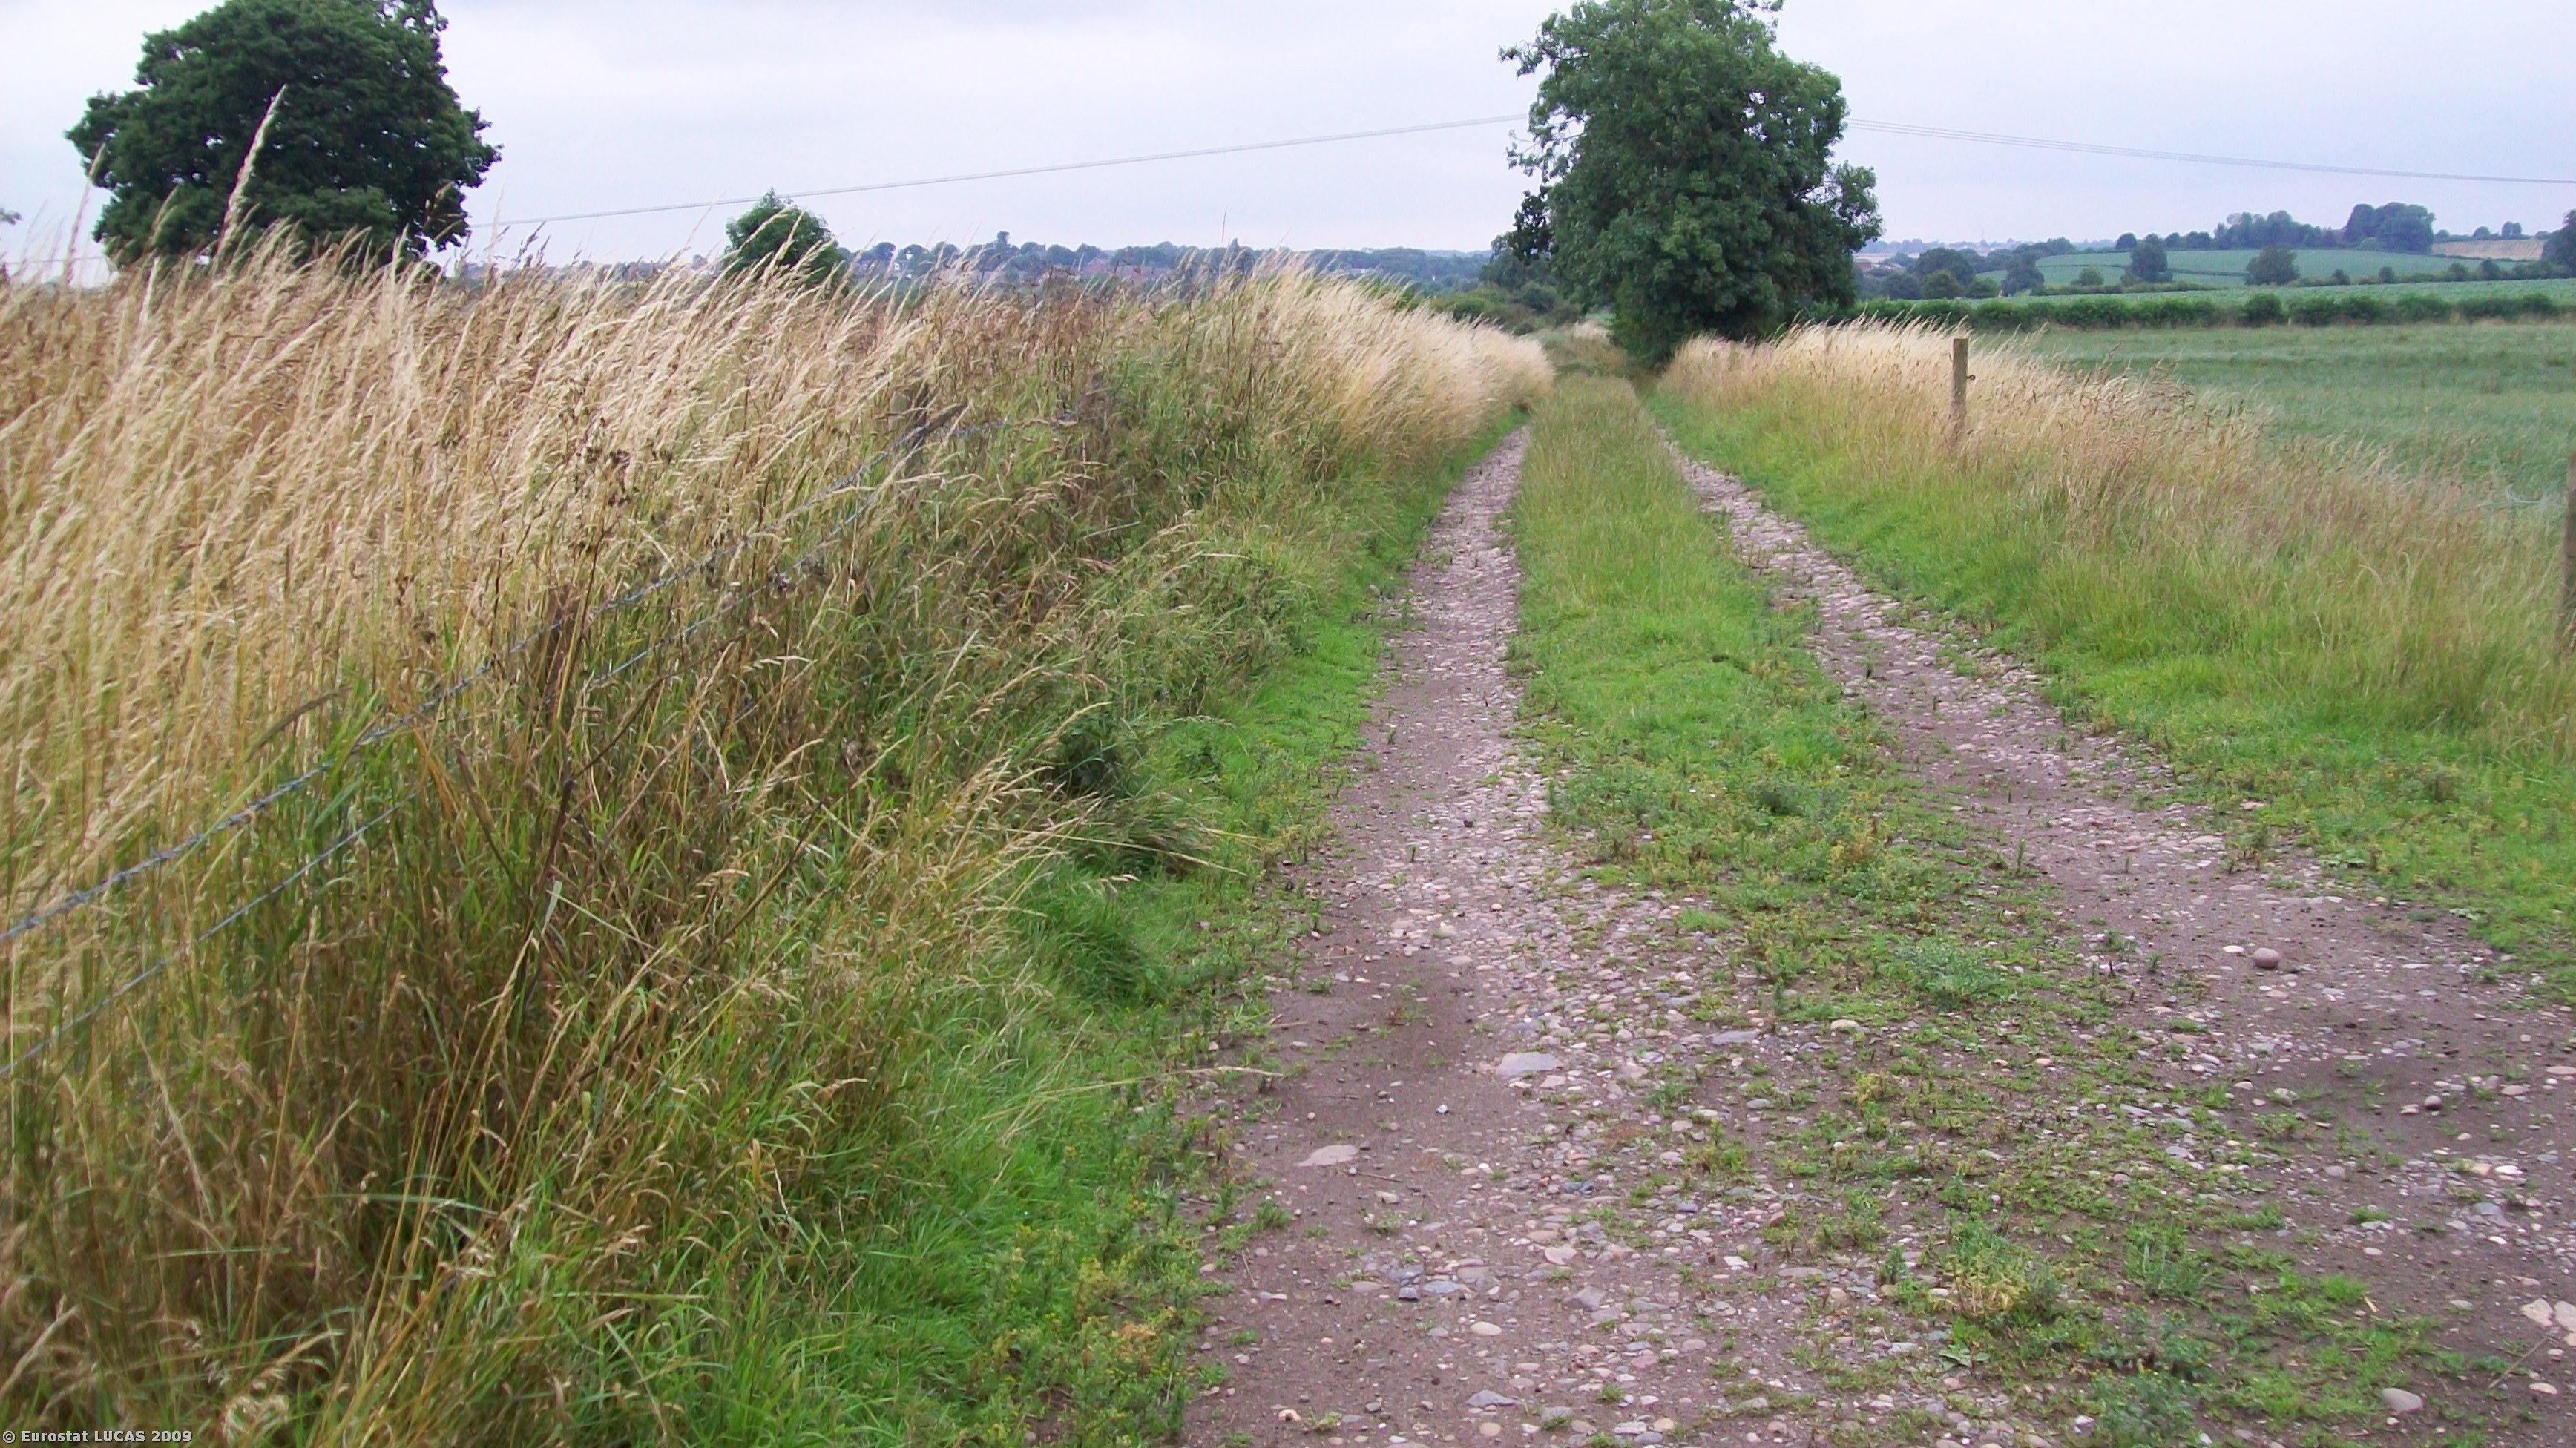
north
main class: Grassland
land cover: Grassland without tree/shrub cover
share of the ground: > 75 %
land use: Agriculture (excluding fallow land and kitchen gardens)
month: July
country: GB
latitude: 52.6776
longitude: -1.4237
